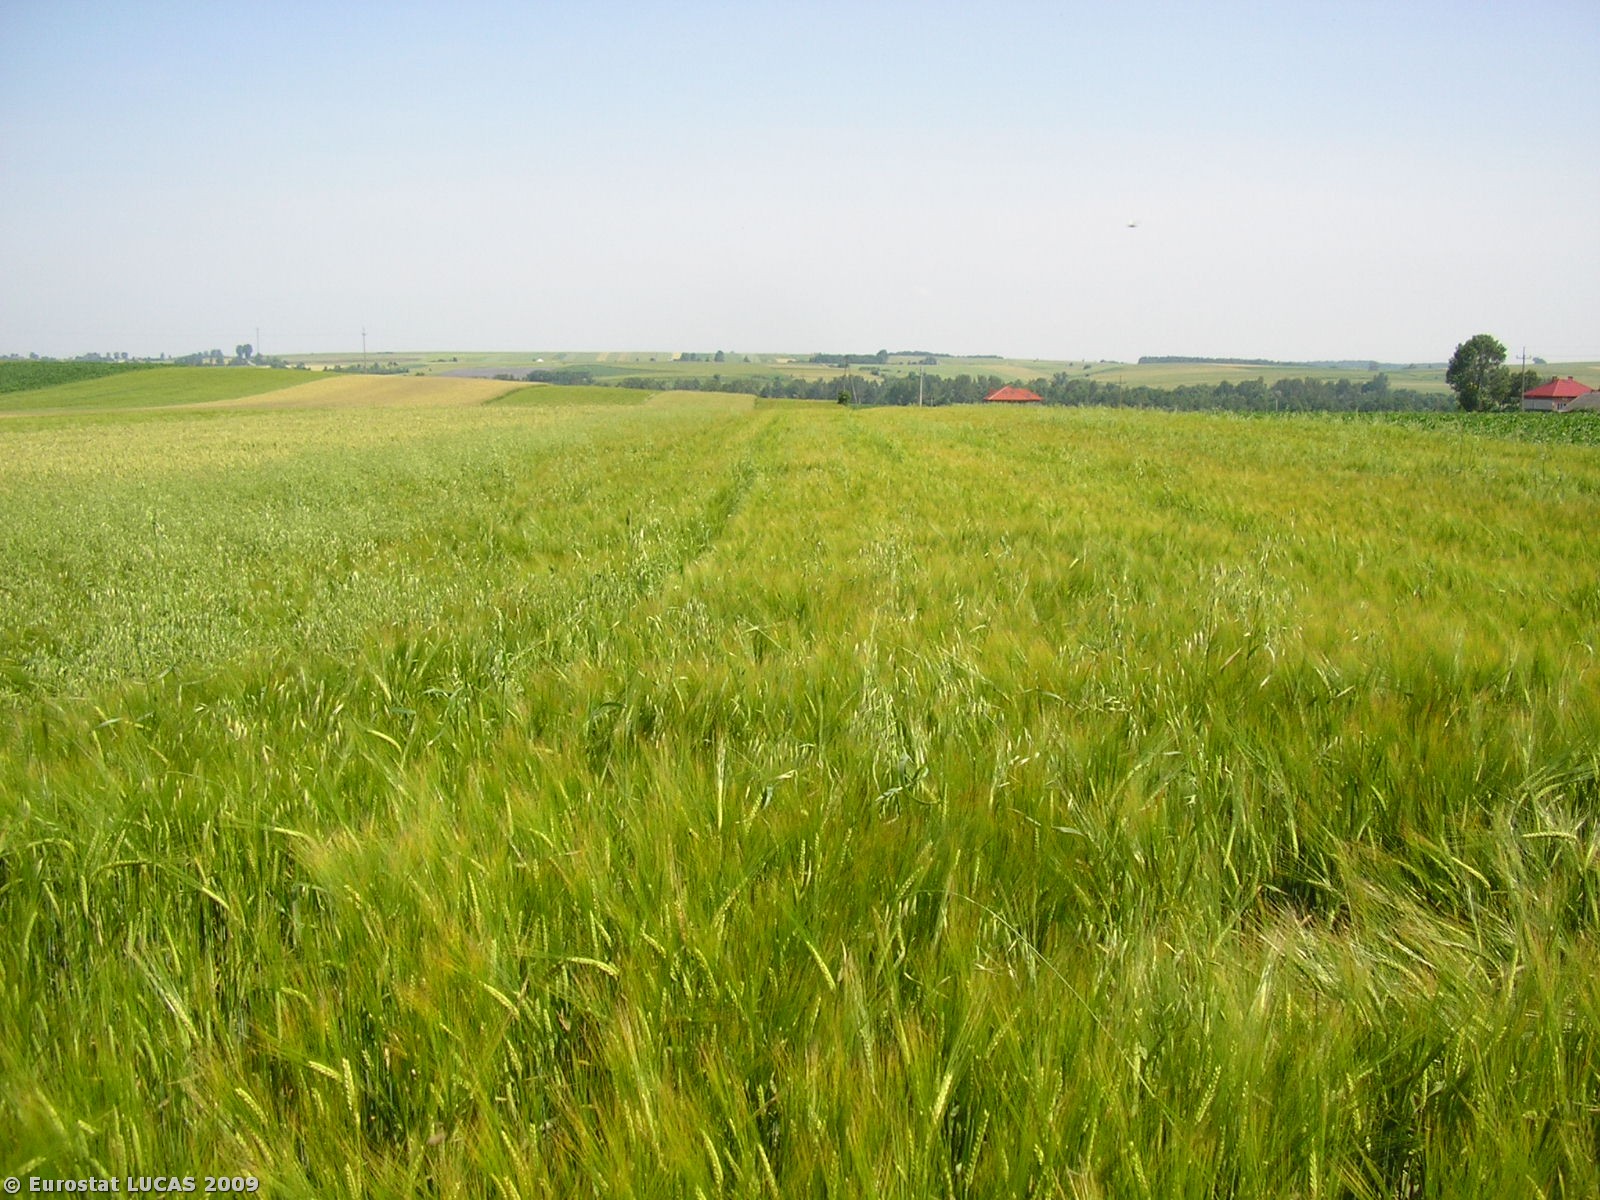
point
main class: Cropland
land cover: Barley
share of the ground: > 75 %
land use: Agriculture (excluding fallow land and kitchen gardens)
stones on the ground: < 10 %
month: June
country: PL
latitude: 50.3705
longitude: 20.2851
